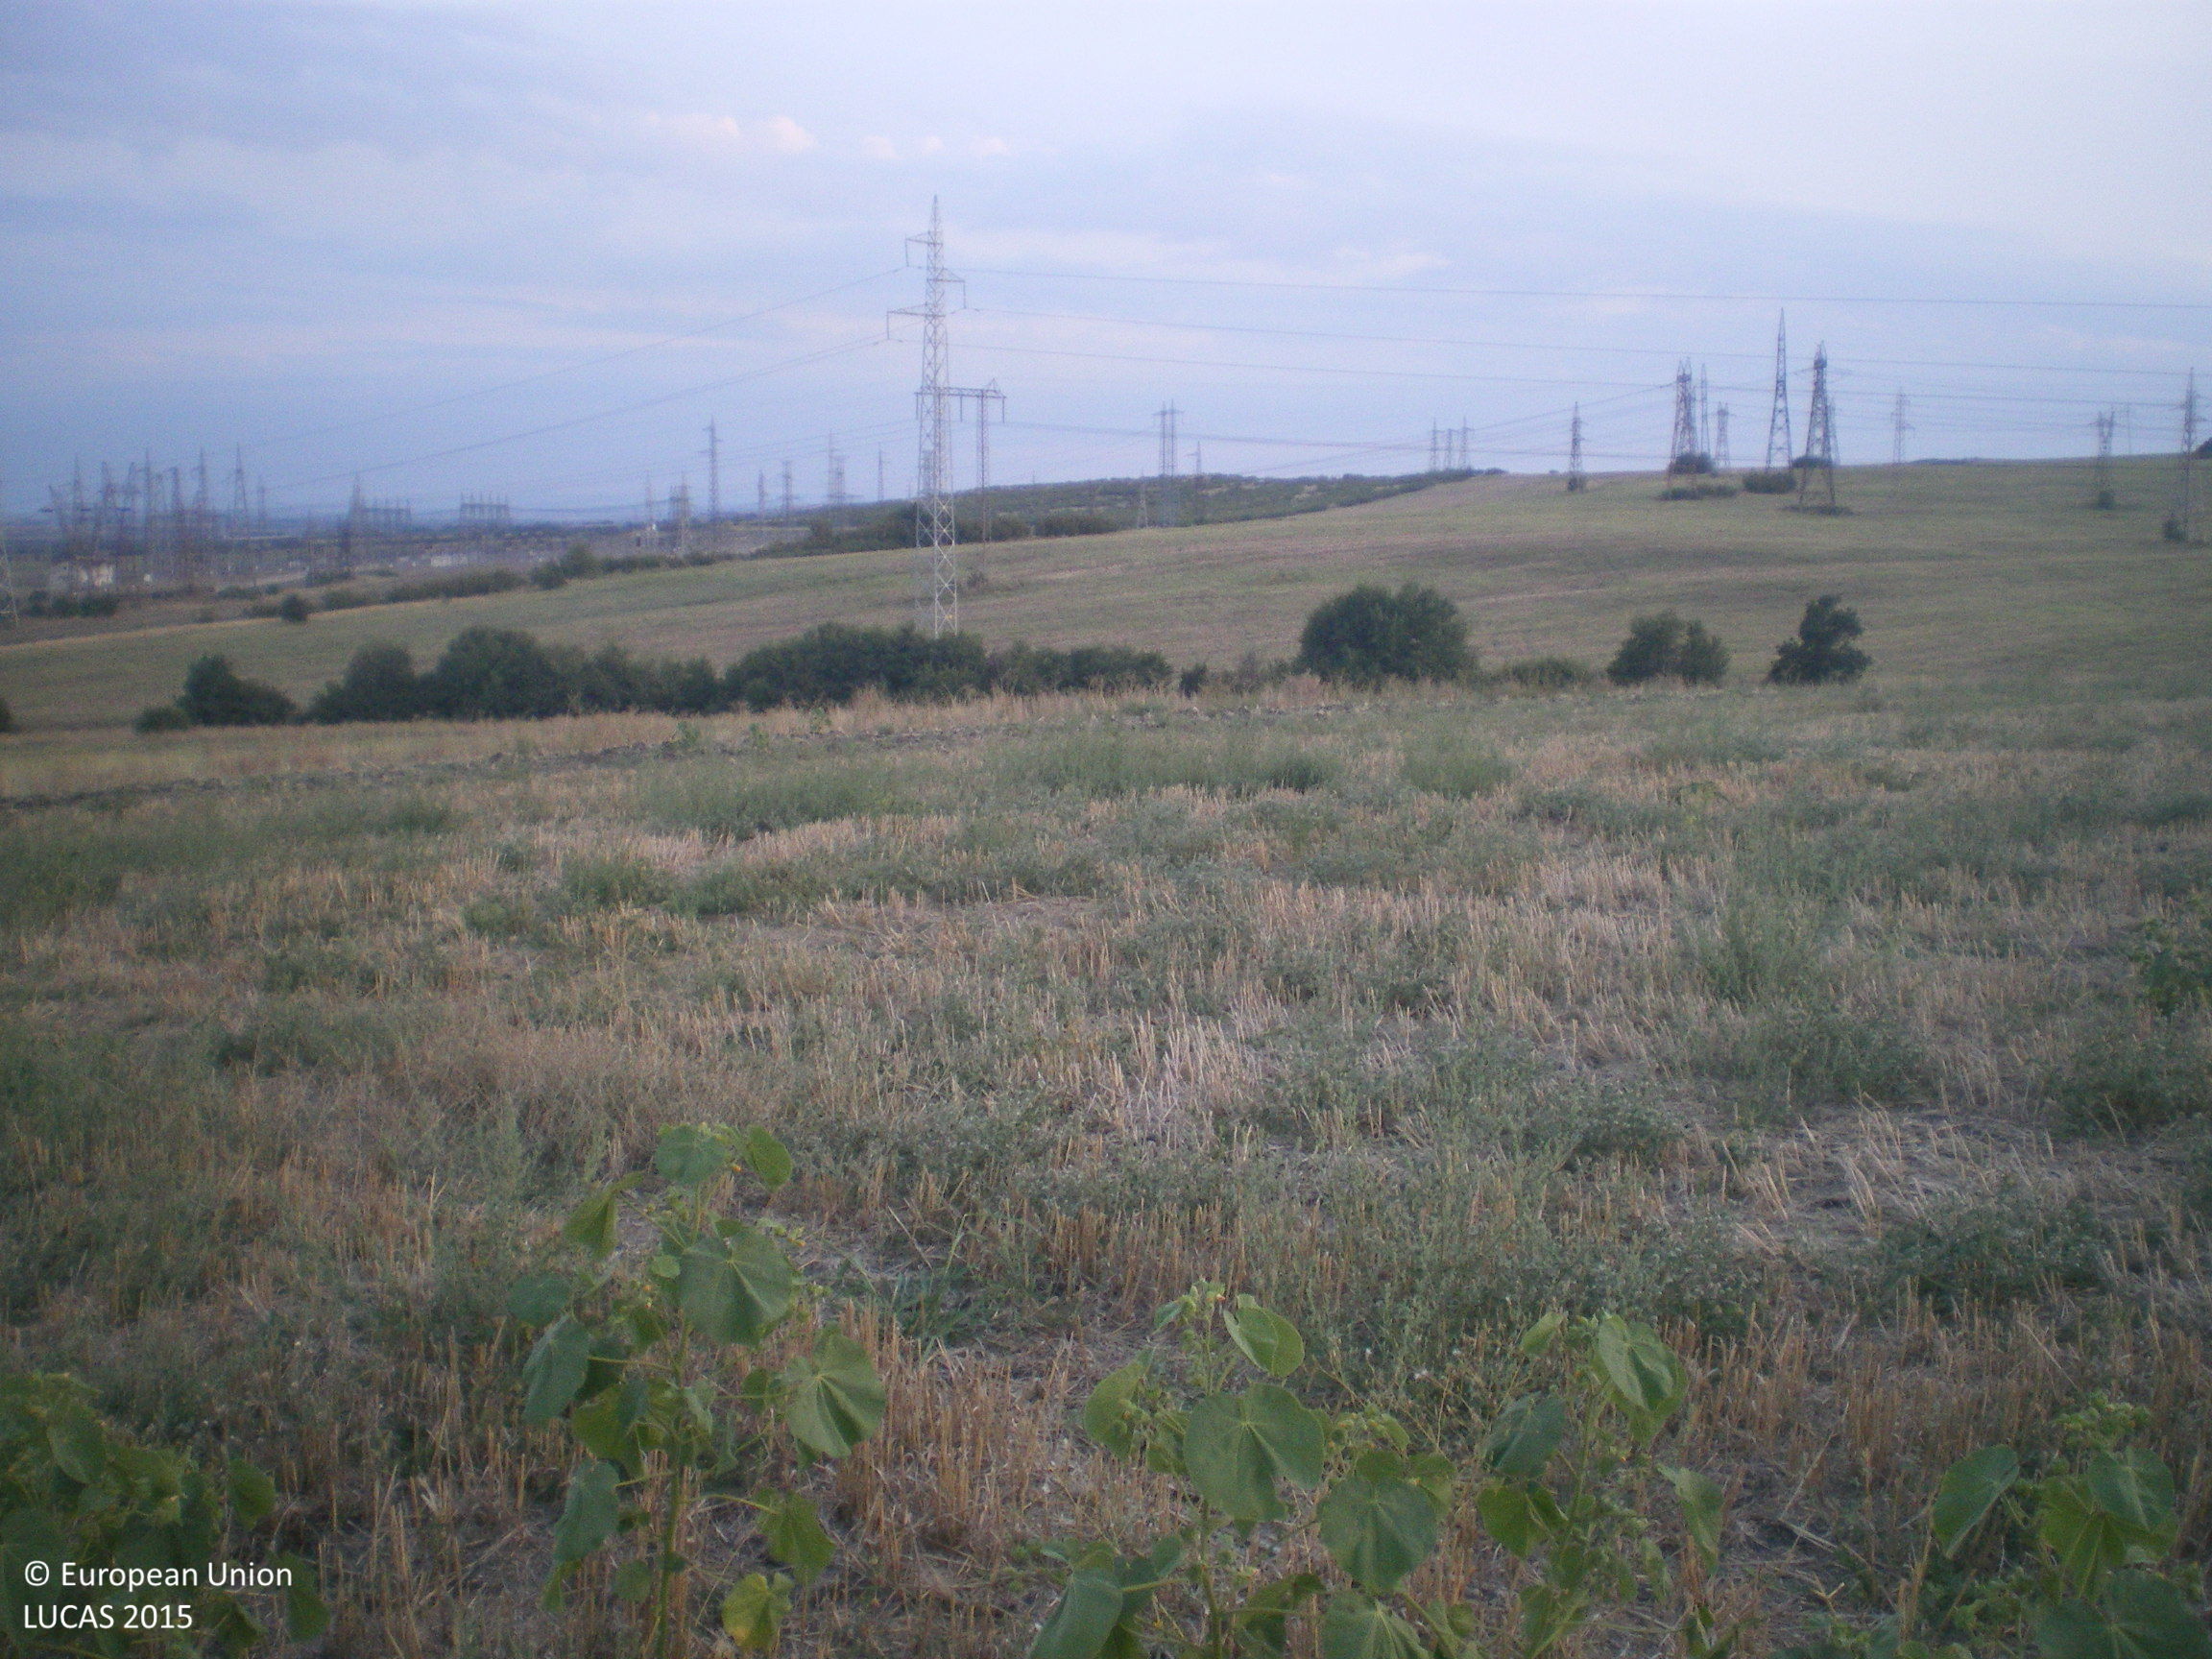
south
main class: Cropland
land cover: Common wheat
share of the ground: < 10 %
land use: Agriculture (excluding fallow land and kitchen gardens)
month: September
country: BG
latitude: 42.1299
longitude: 25.8603
